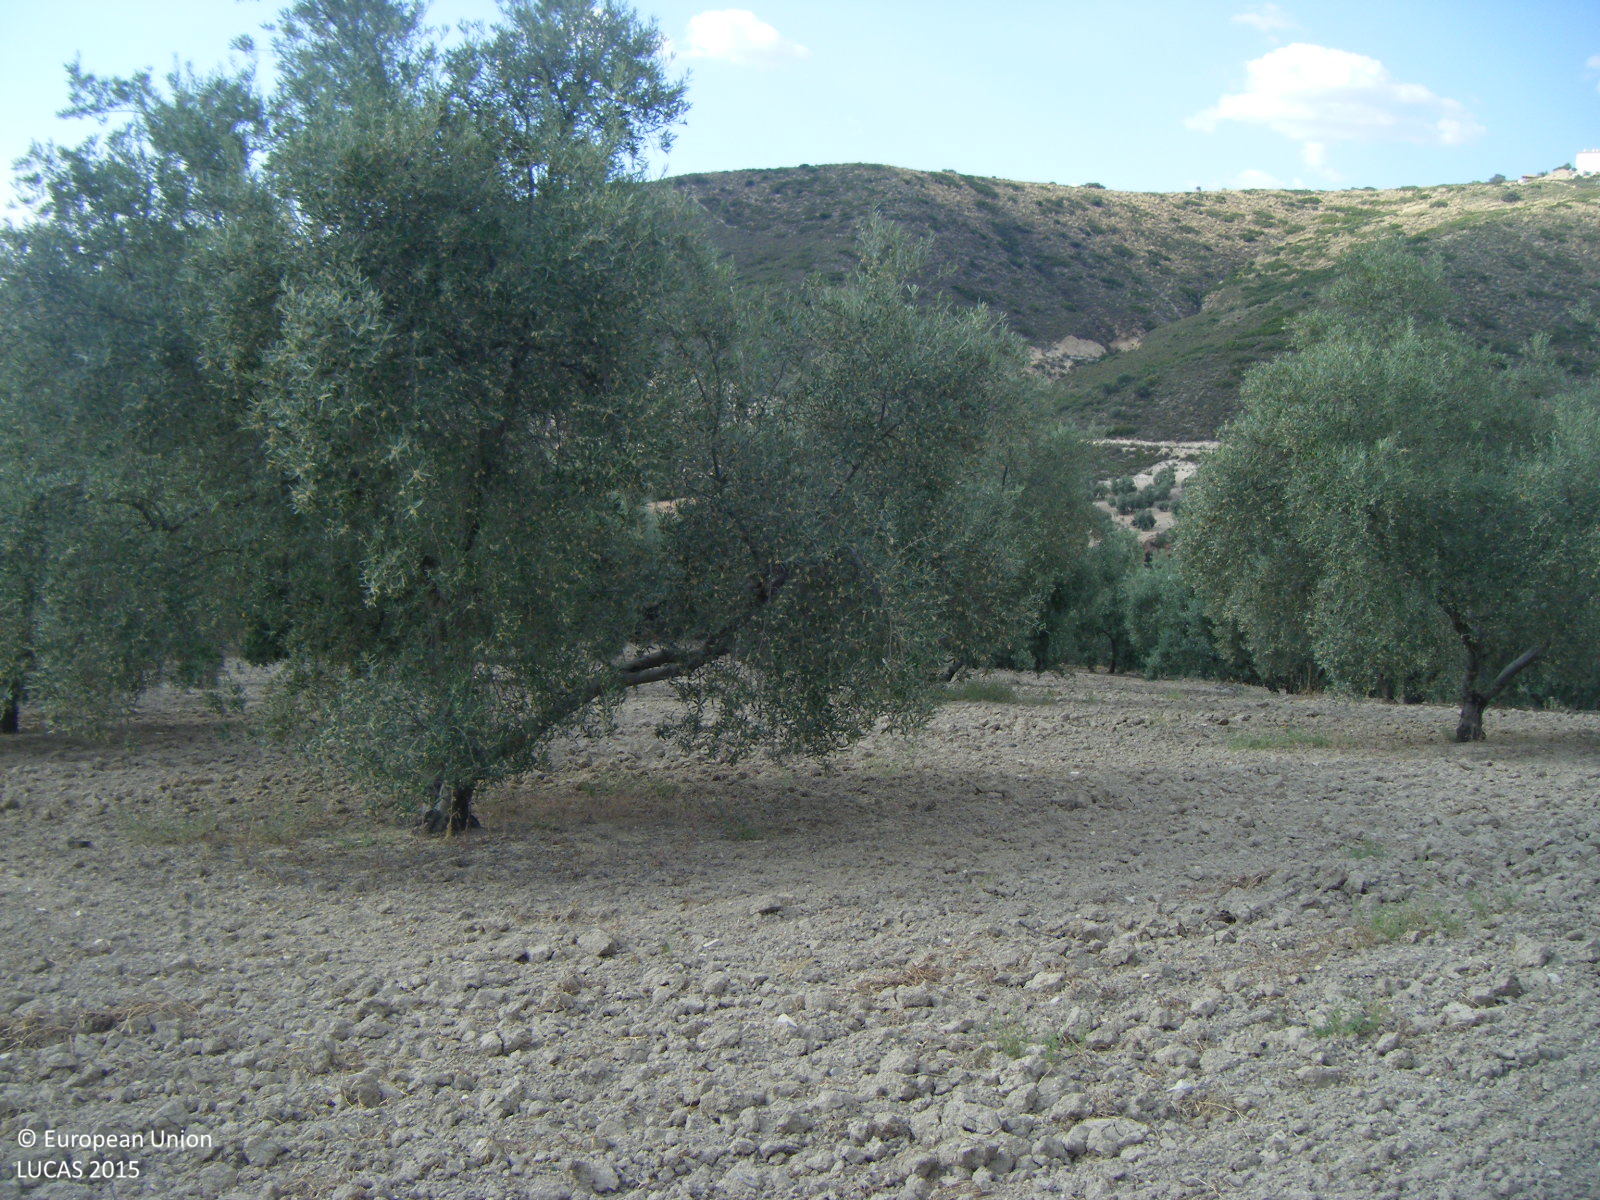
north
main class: Cropland
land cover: Olive groves
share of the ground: 10 - 25 %
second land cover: Other bare soil
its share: > 75 %
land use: Agriculture (excluding fallow land and kitchen gardens)
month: May
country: ES
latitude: 37.2281
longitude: -4.4368
